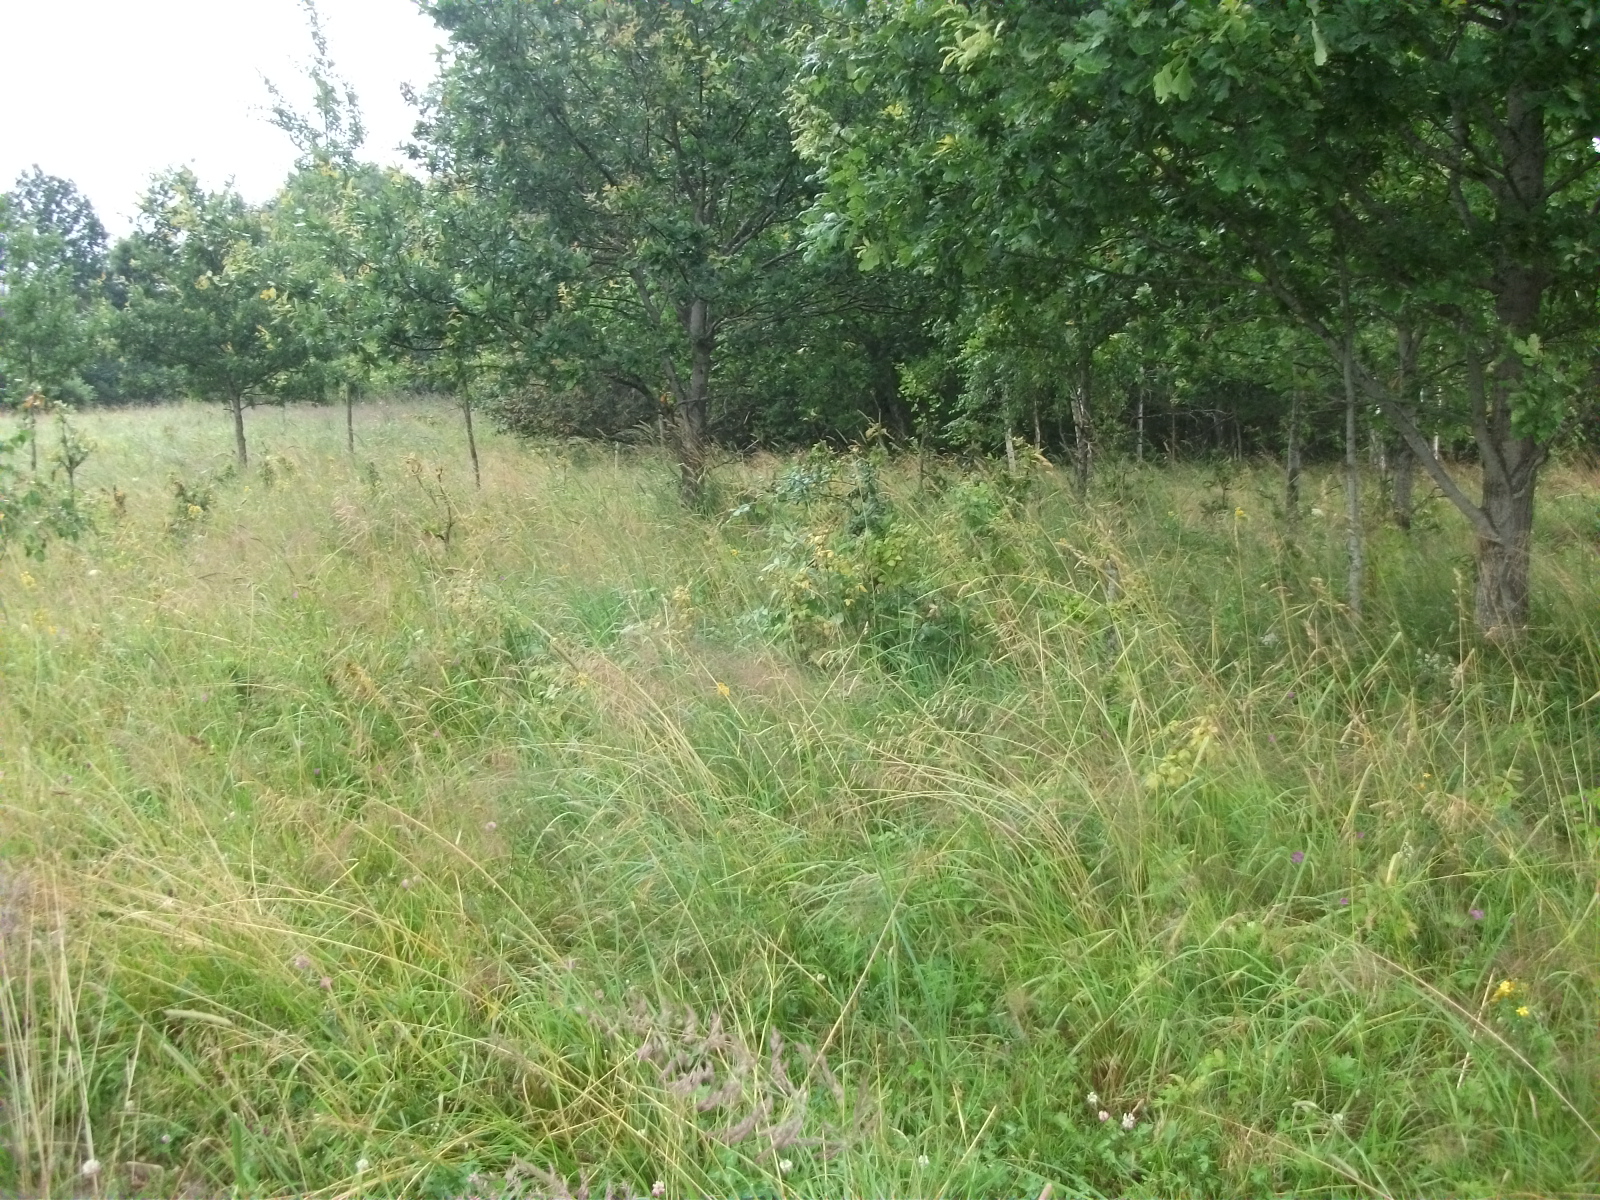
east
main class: Grassland
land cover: Grassland with sparse tree/shrub cover
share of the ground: > 75 %
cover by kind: herbaceous plants 90 %, broadleaved forest trees 5 %, shrubs 5 %
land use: Agriculture (excluding fallow land and kitchen gardens)
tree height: < 5 m
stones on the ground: < 10 %
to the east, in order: Grassland with sparse tree/shrub cover; Broadleaved woodland; Electric lines; Grassland without tree/shrub cover; Electric lines; Grassland without tree/shrub cover; Electric lines; Grassland without tree/shrub cover; Grassland with sparse tree/shrub cover; Broadleaved woodland
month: July
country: LV
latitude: 56.7847
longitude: 25.7572
